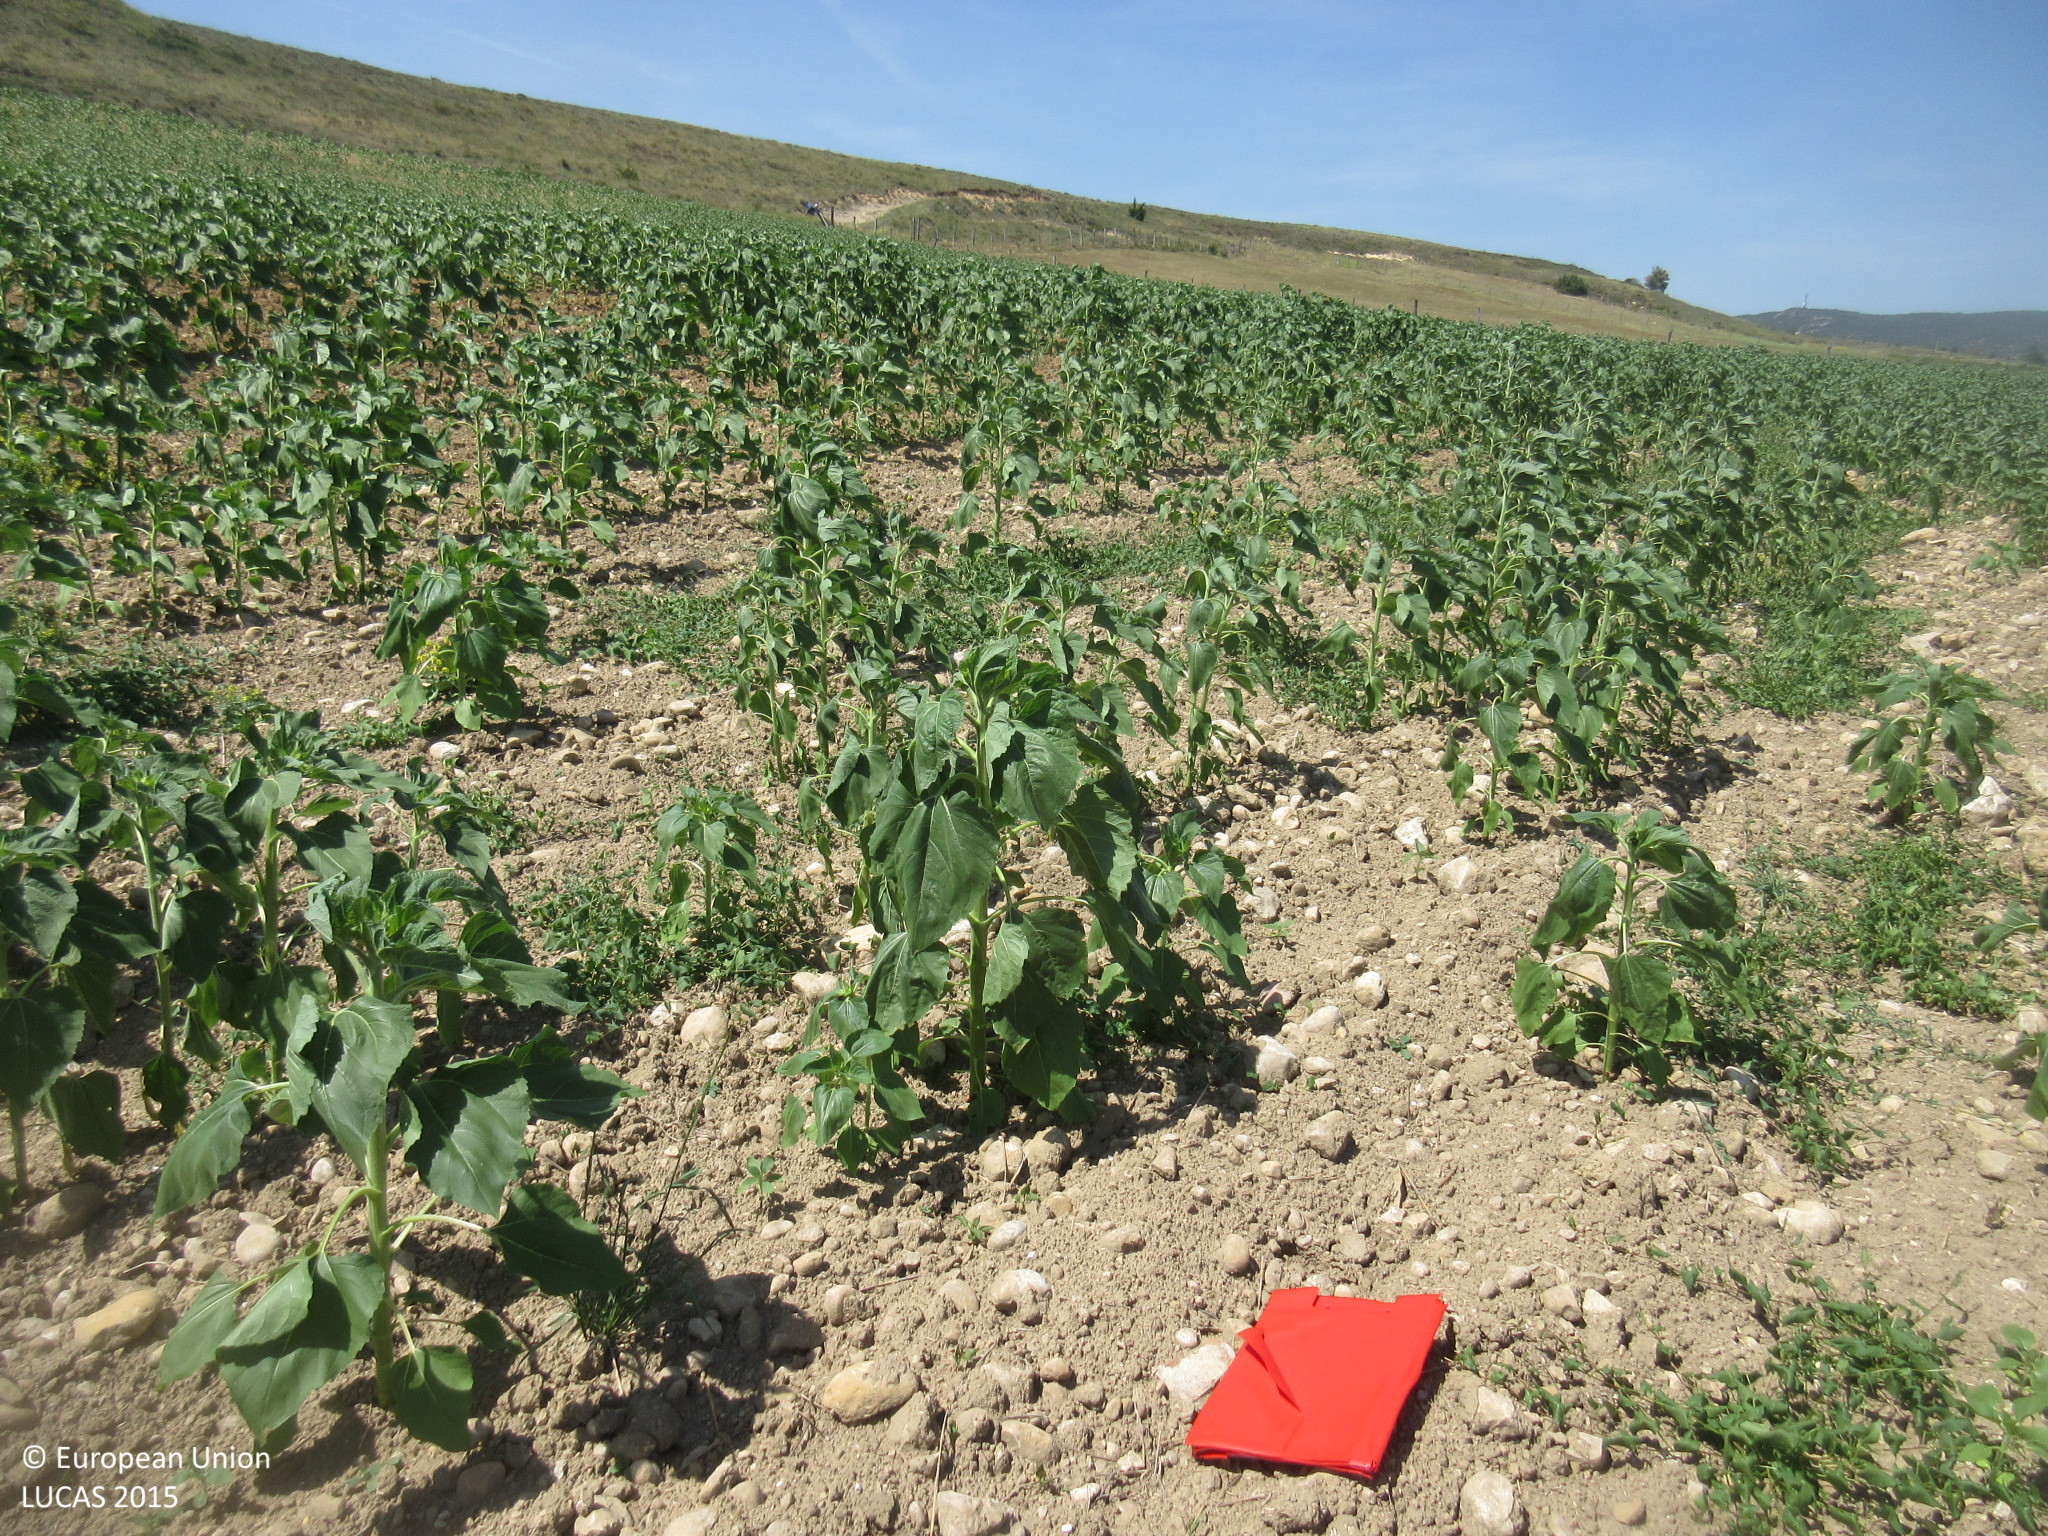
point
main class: Cropland
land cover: Sunflower
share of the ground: 50 - 75 %
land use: Agriculture (excluding fallow land and kitchen gardens)
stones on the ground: 25 - 50 %
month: July
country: ES
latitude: 42.9540
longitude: -3.4858
